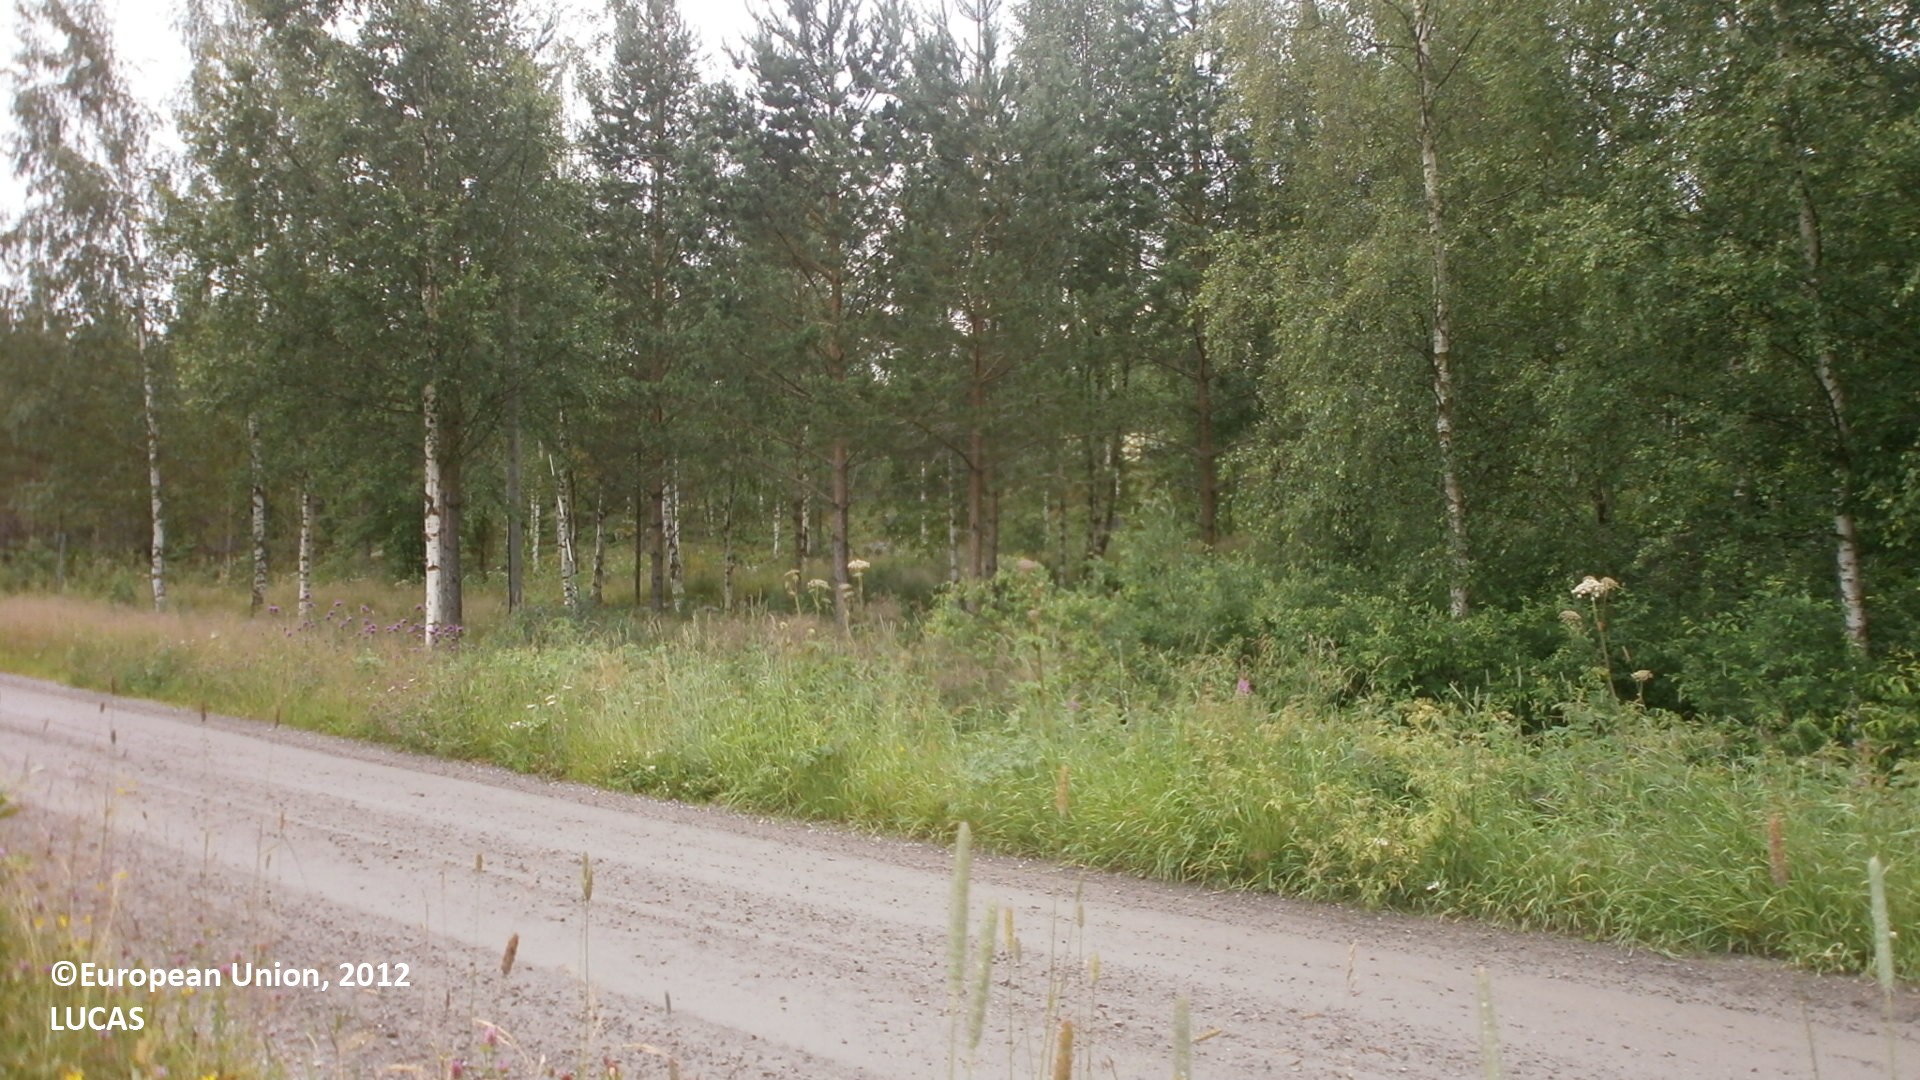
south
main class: Grassland
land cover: Grassland without tree/shrub cover
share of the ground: > 75 %
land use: Road transport
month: July
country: FI
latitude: 63.9781
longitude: 23.7701
